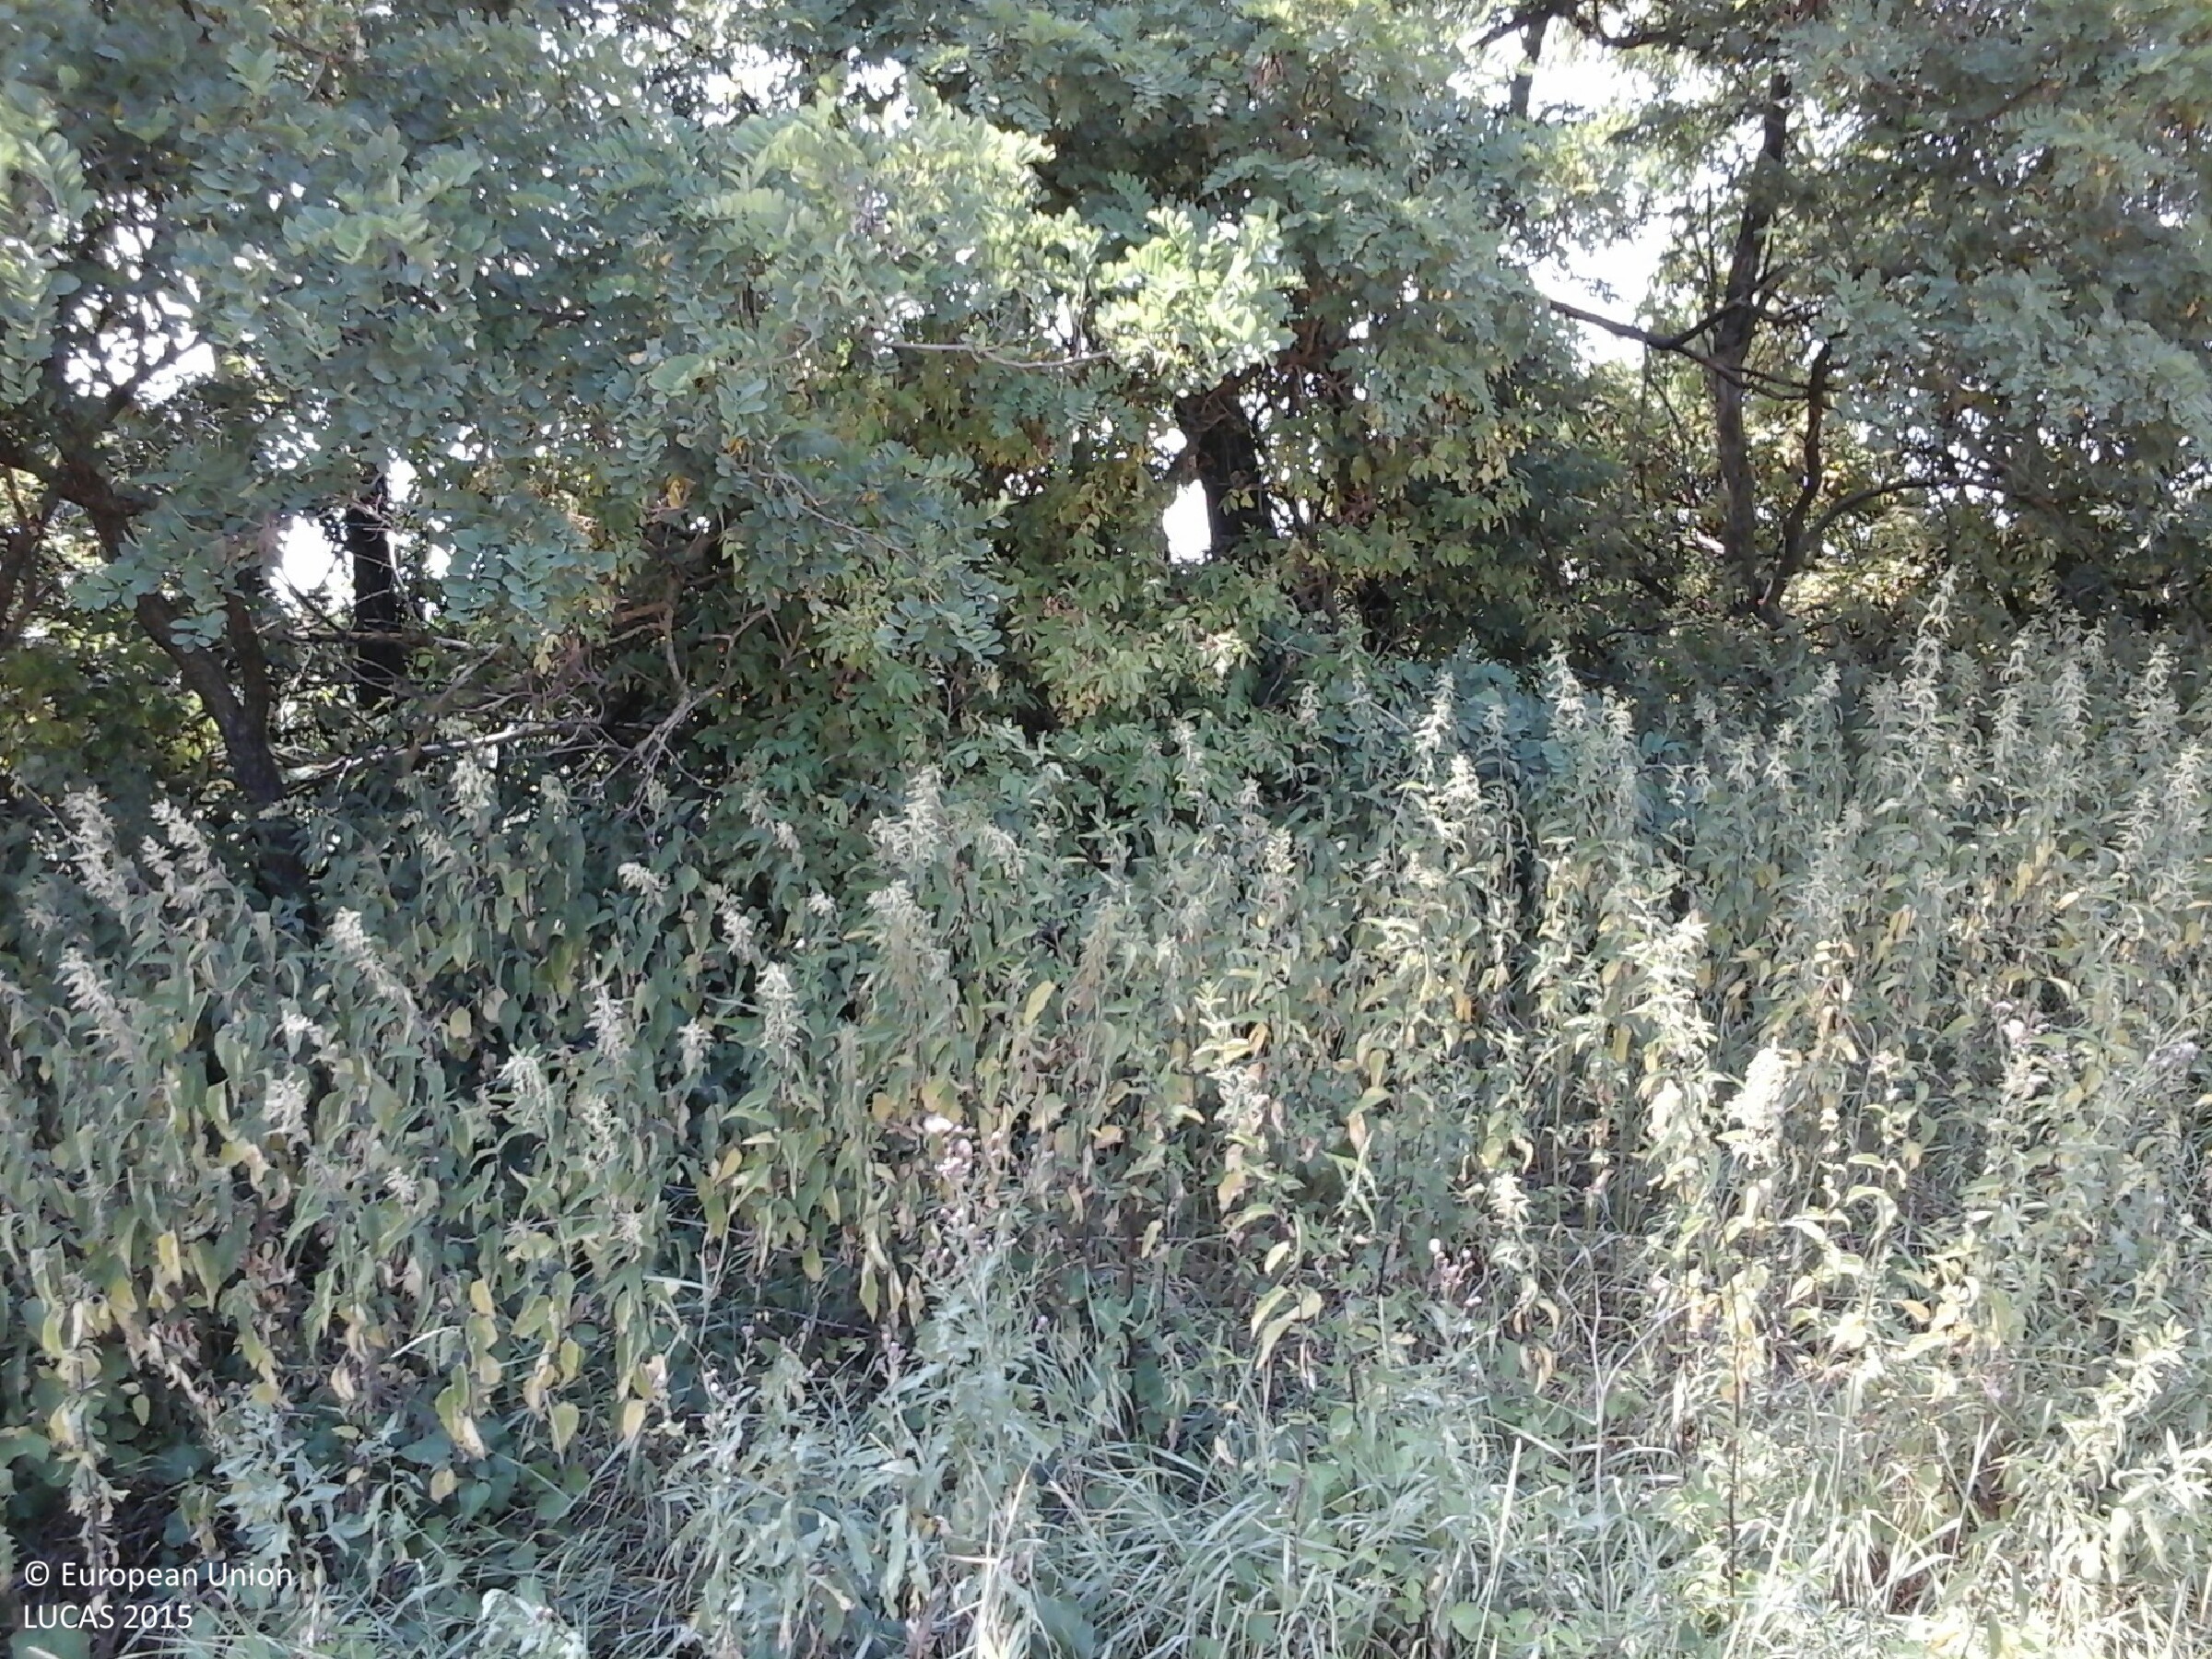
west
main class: Cropland
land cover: Common wheat
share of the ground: > 75 %
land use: Agriculture (excluding fallow land and kitchen gardens)
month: July
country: HU
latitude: 48.0828
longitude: 21.0610
